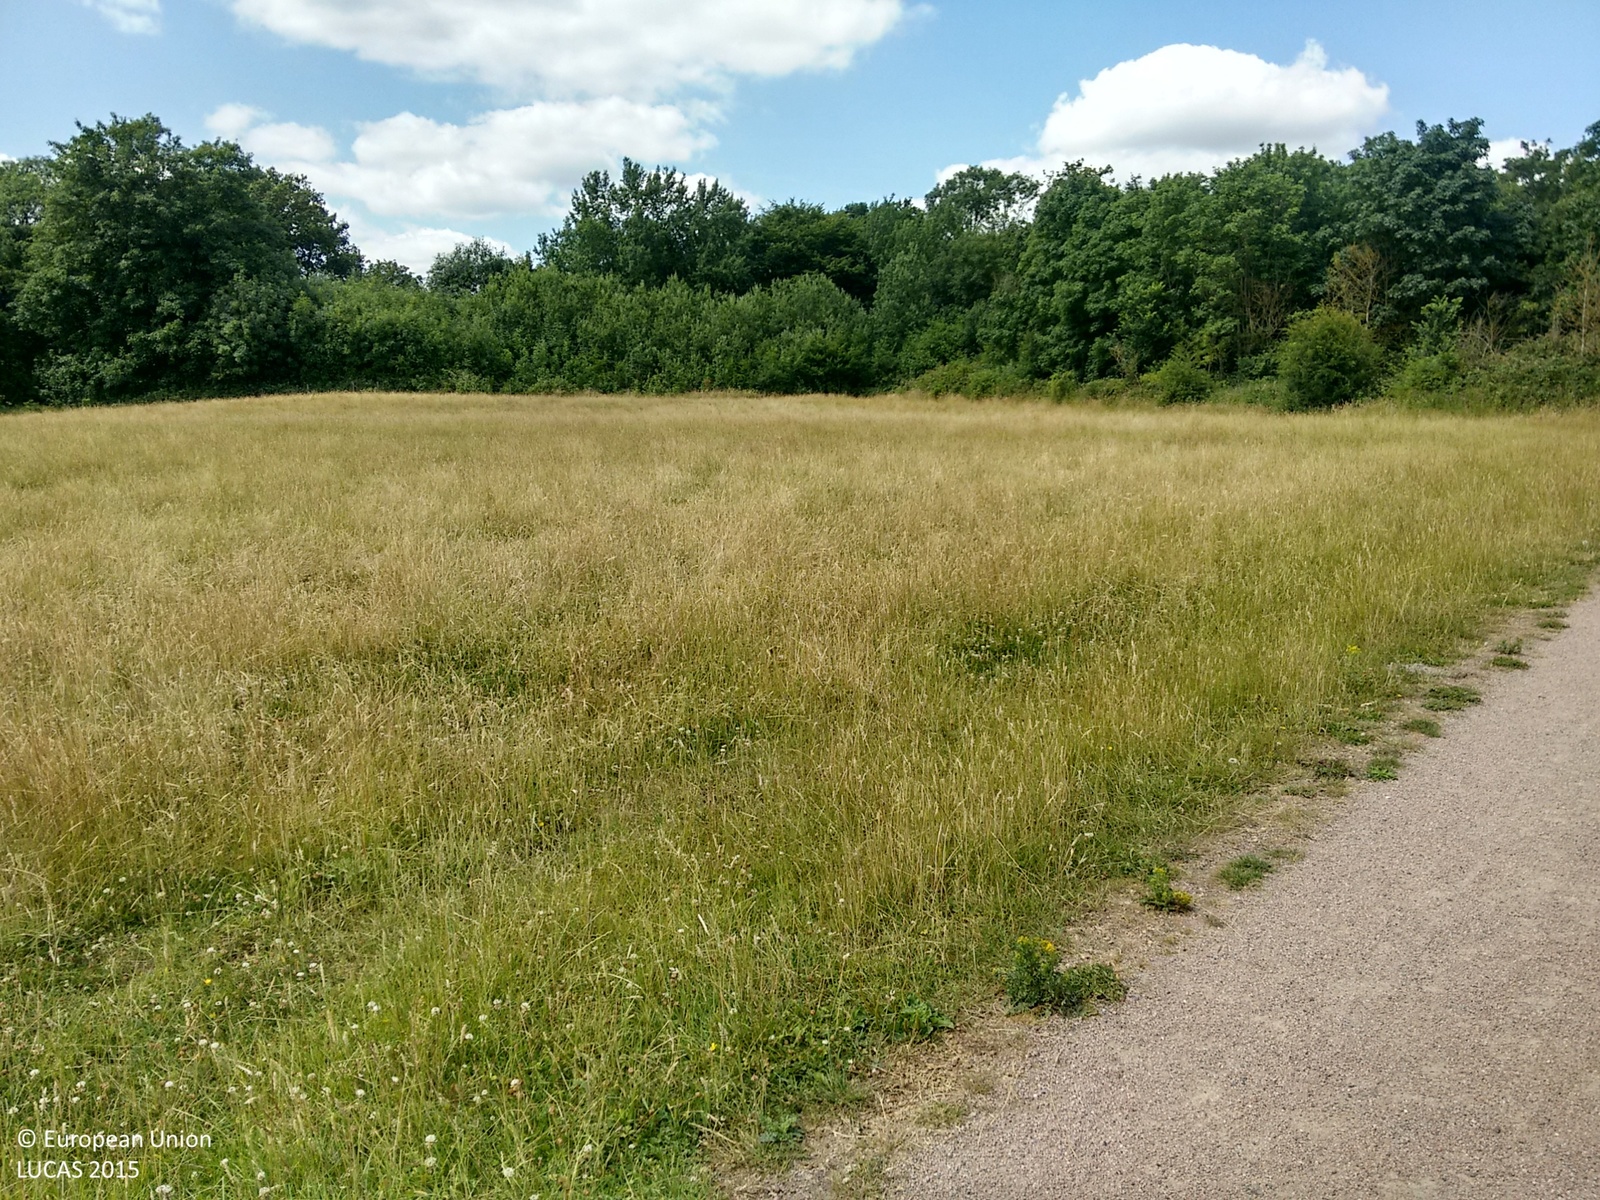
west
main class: Grassland
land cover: Grassland without tree/shrub cover
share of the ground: > 75 %
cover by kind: herbaceous plants 100 %
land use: Agriculture (excluding fallow land and kitchen gardens)
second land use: Amenities, museums, leisure
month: July
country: GB
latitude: 51.5846
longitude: 0.3443
